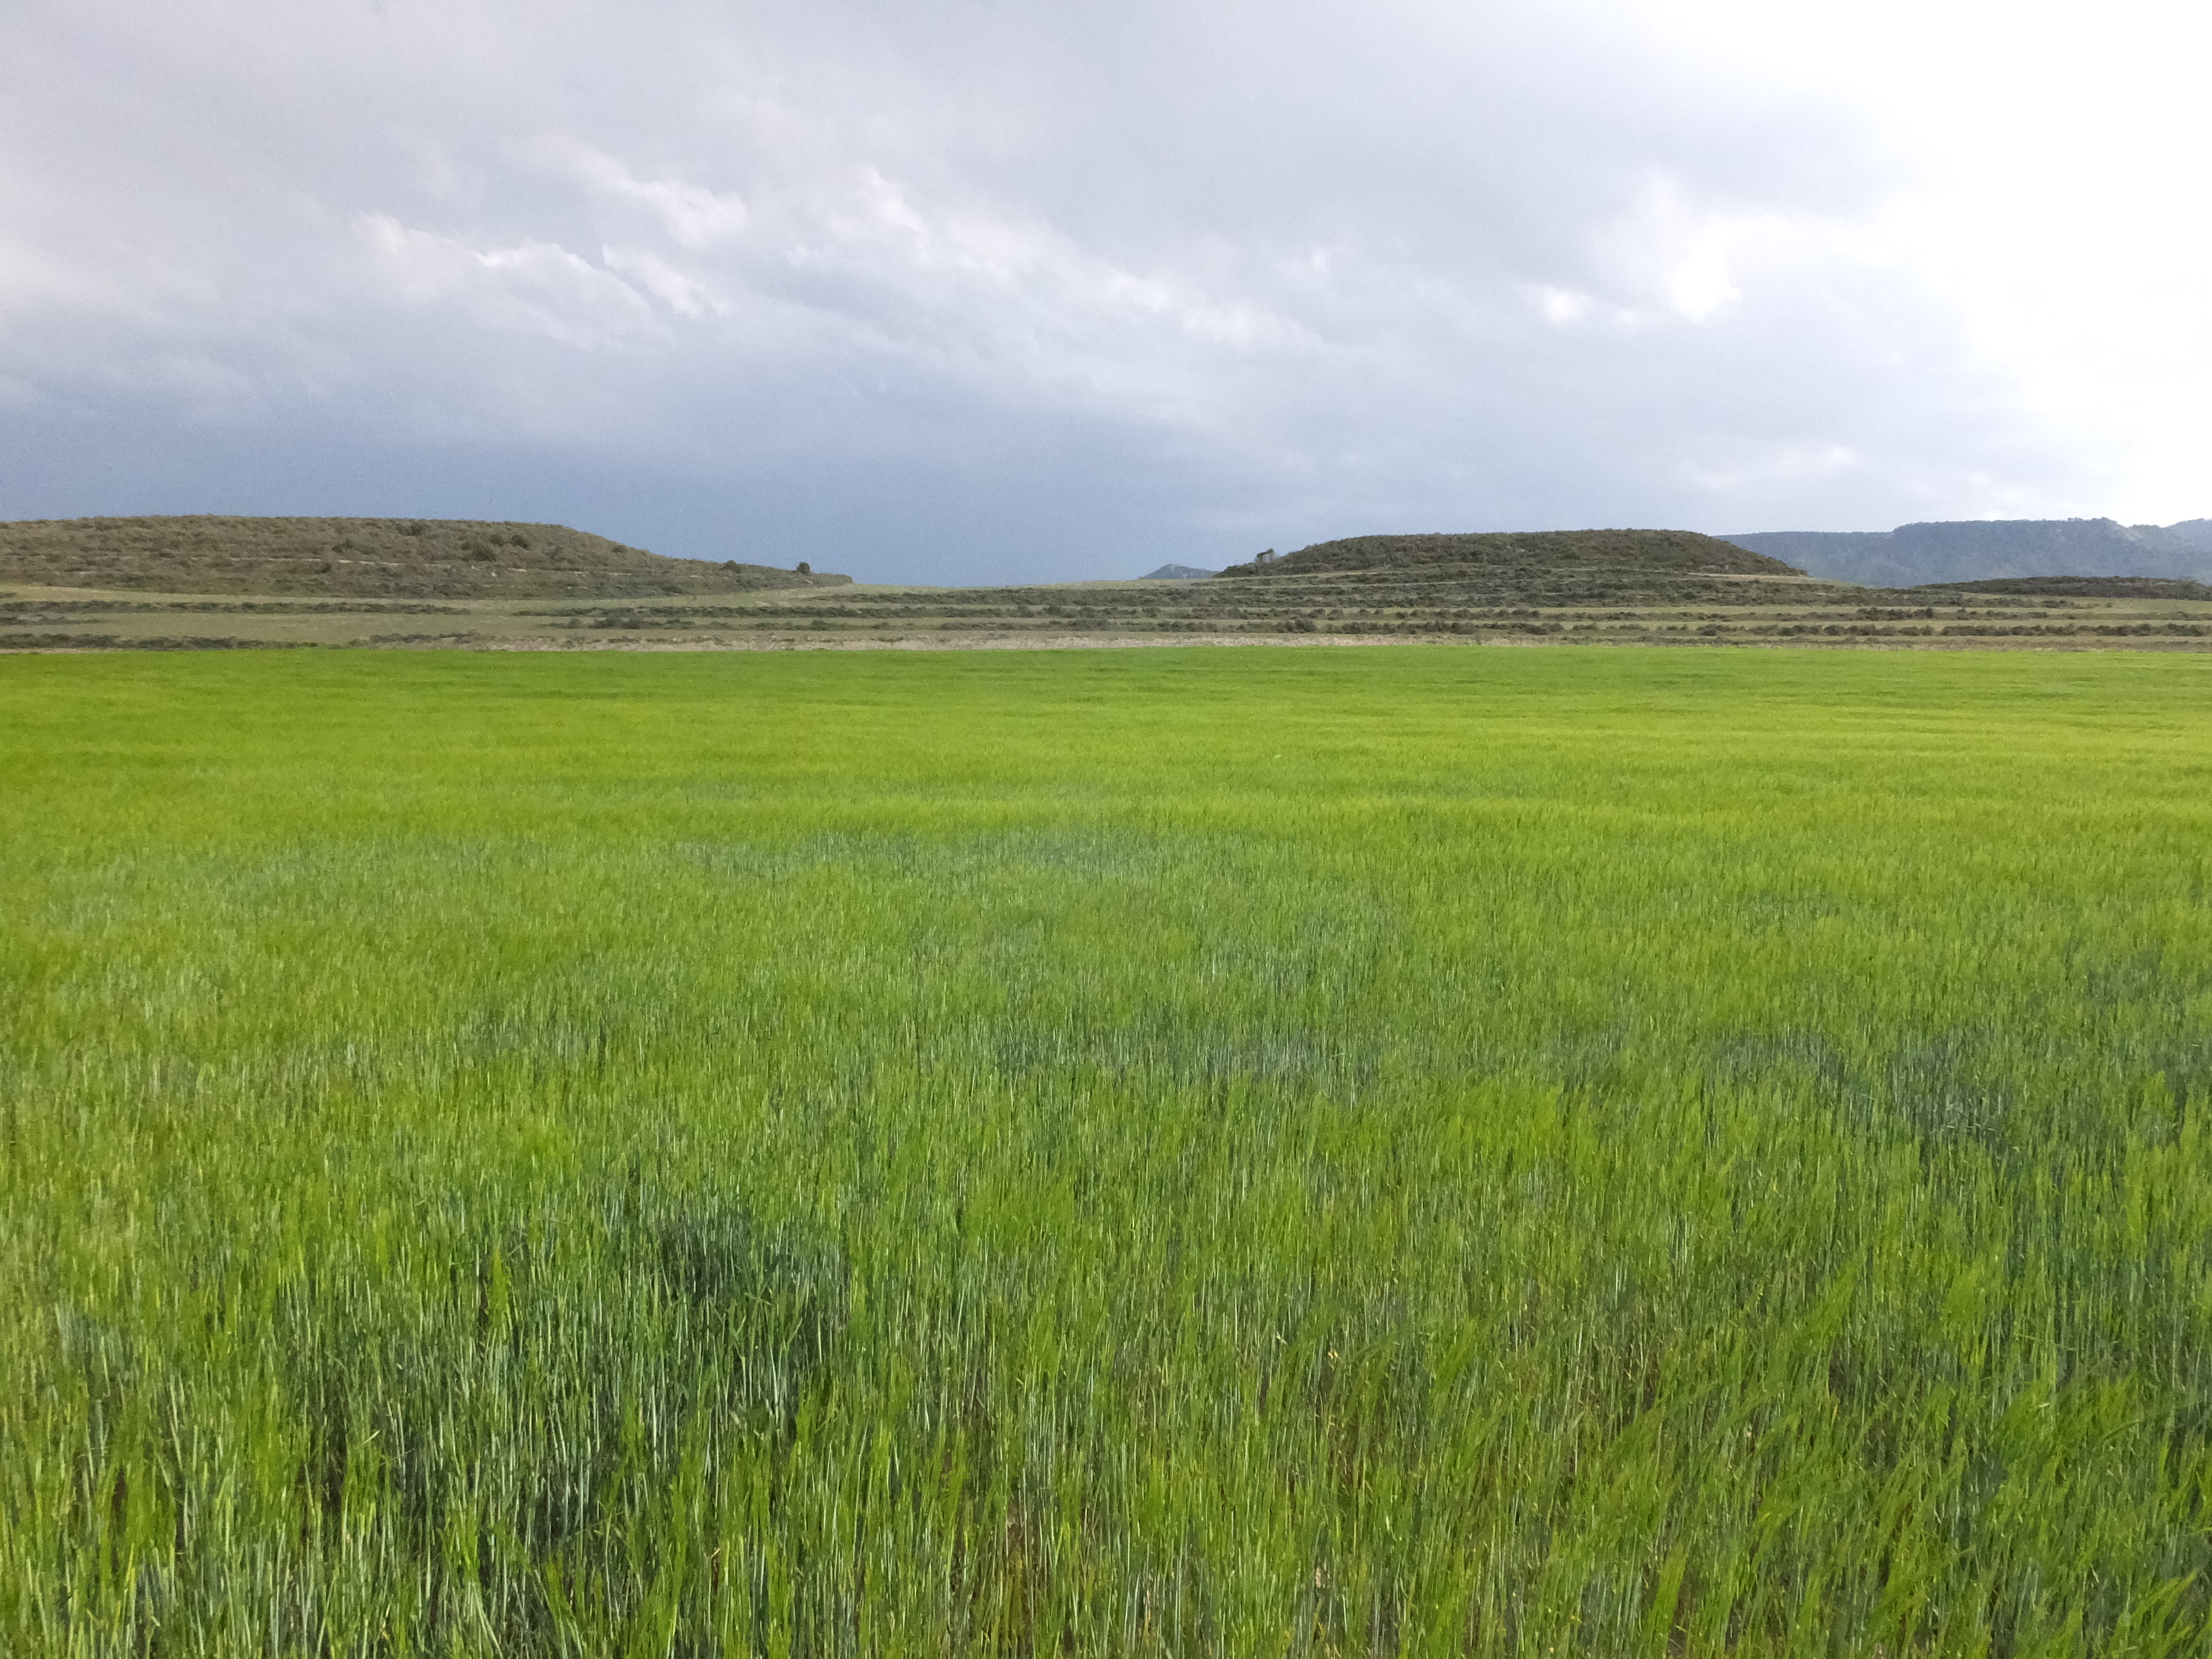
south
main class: Cropland
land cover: Barley
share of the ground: > 75 %
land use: Agriculture (excluding fallow land and kitchen gardens)
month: April
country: ES
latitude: 41.7227
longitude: -0.3444
